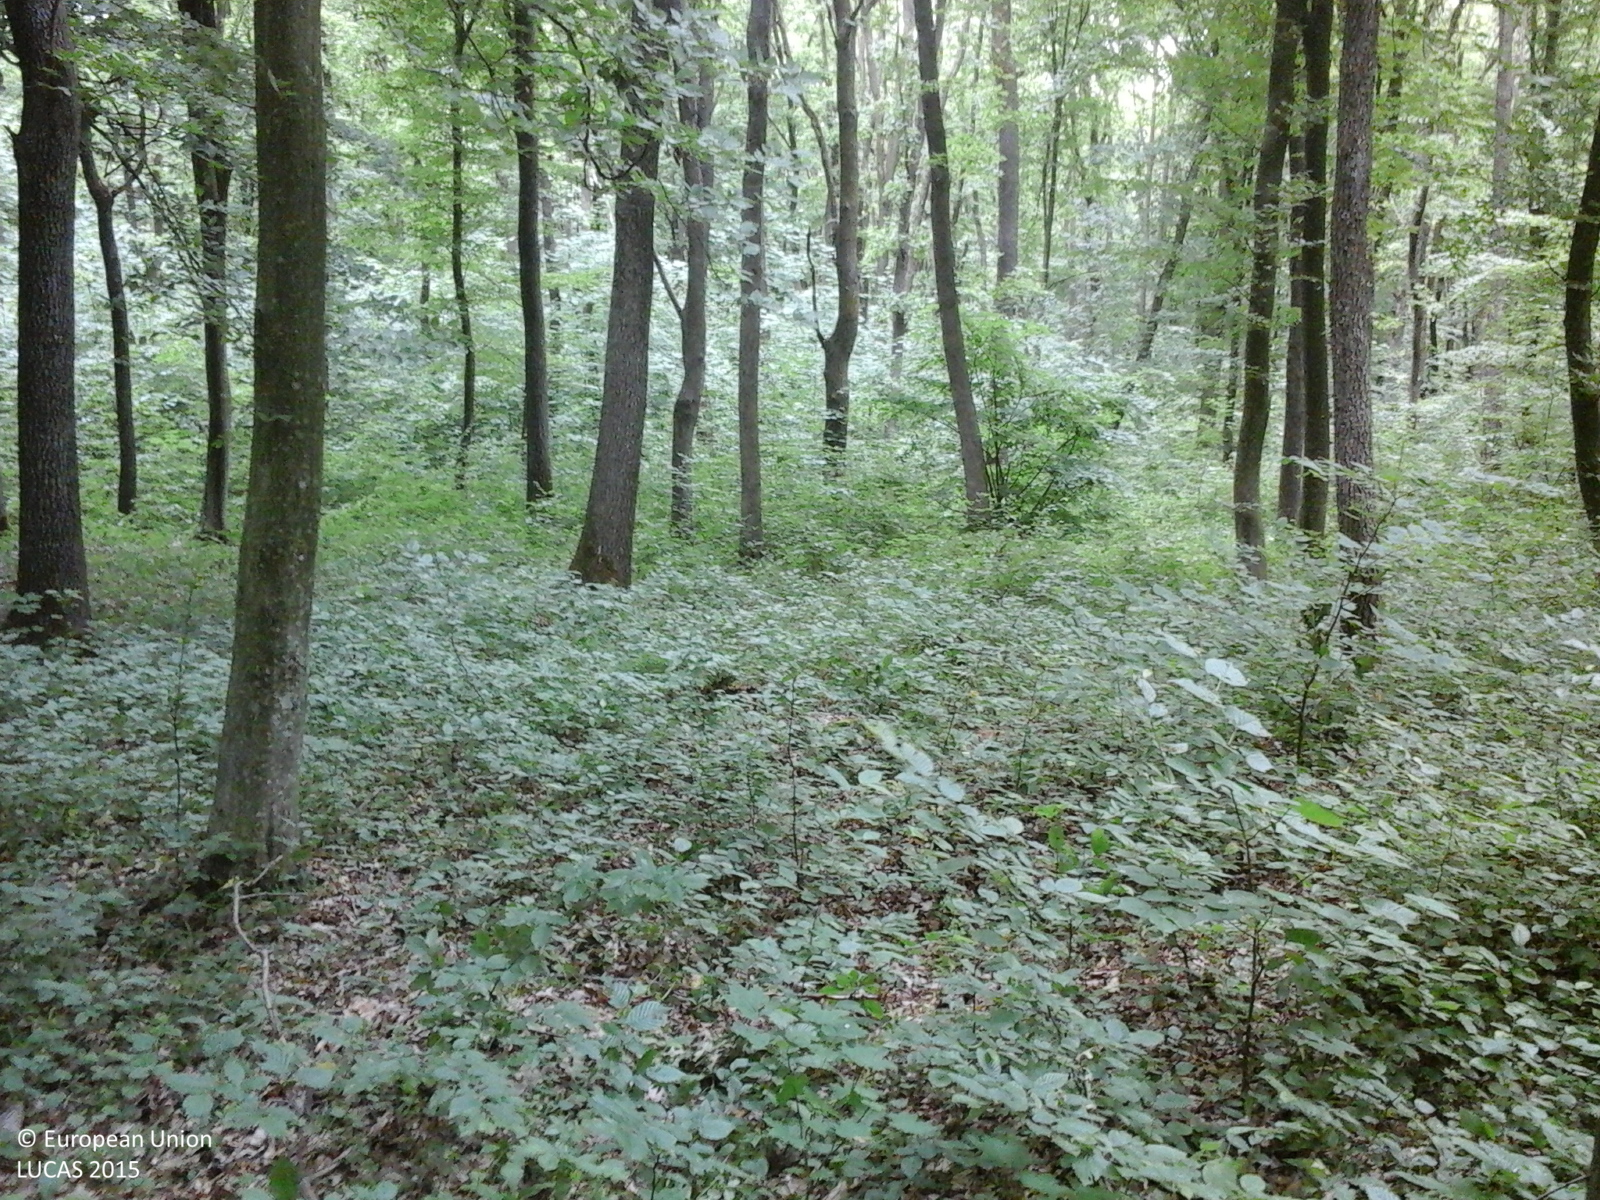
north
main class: Woodland
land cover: Broadleaved woodland
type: beech forest
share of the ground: > 75 %
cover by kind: broadleaved forest trees 100 %
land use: Forestry
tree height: > 5 m
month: June
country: RO
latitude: 47.2333
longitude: 26.4513
